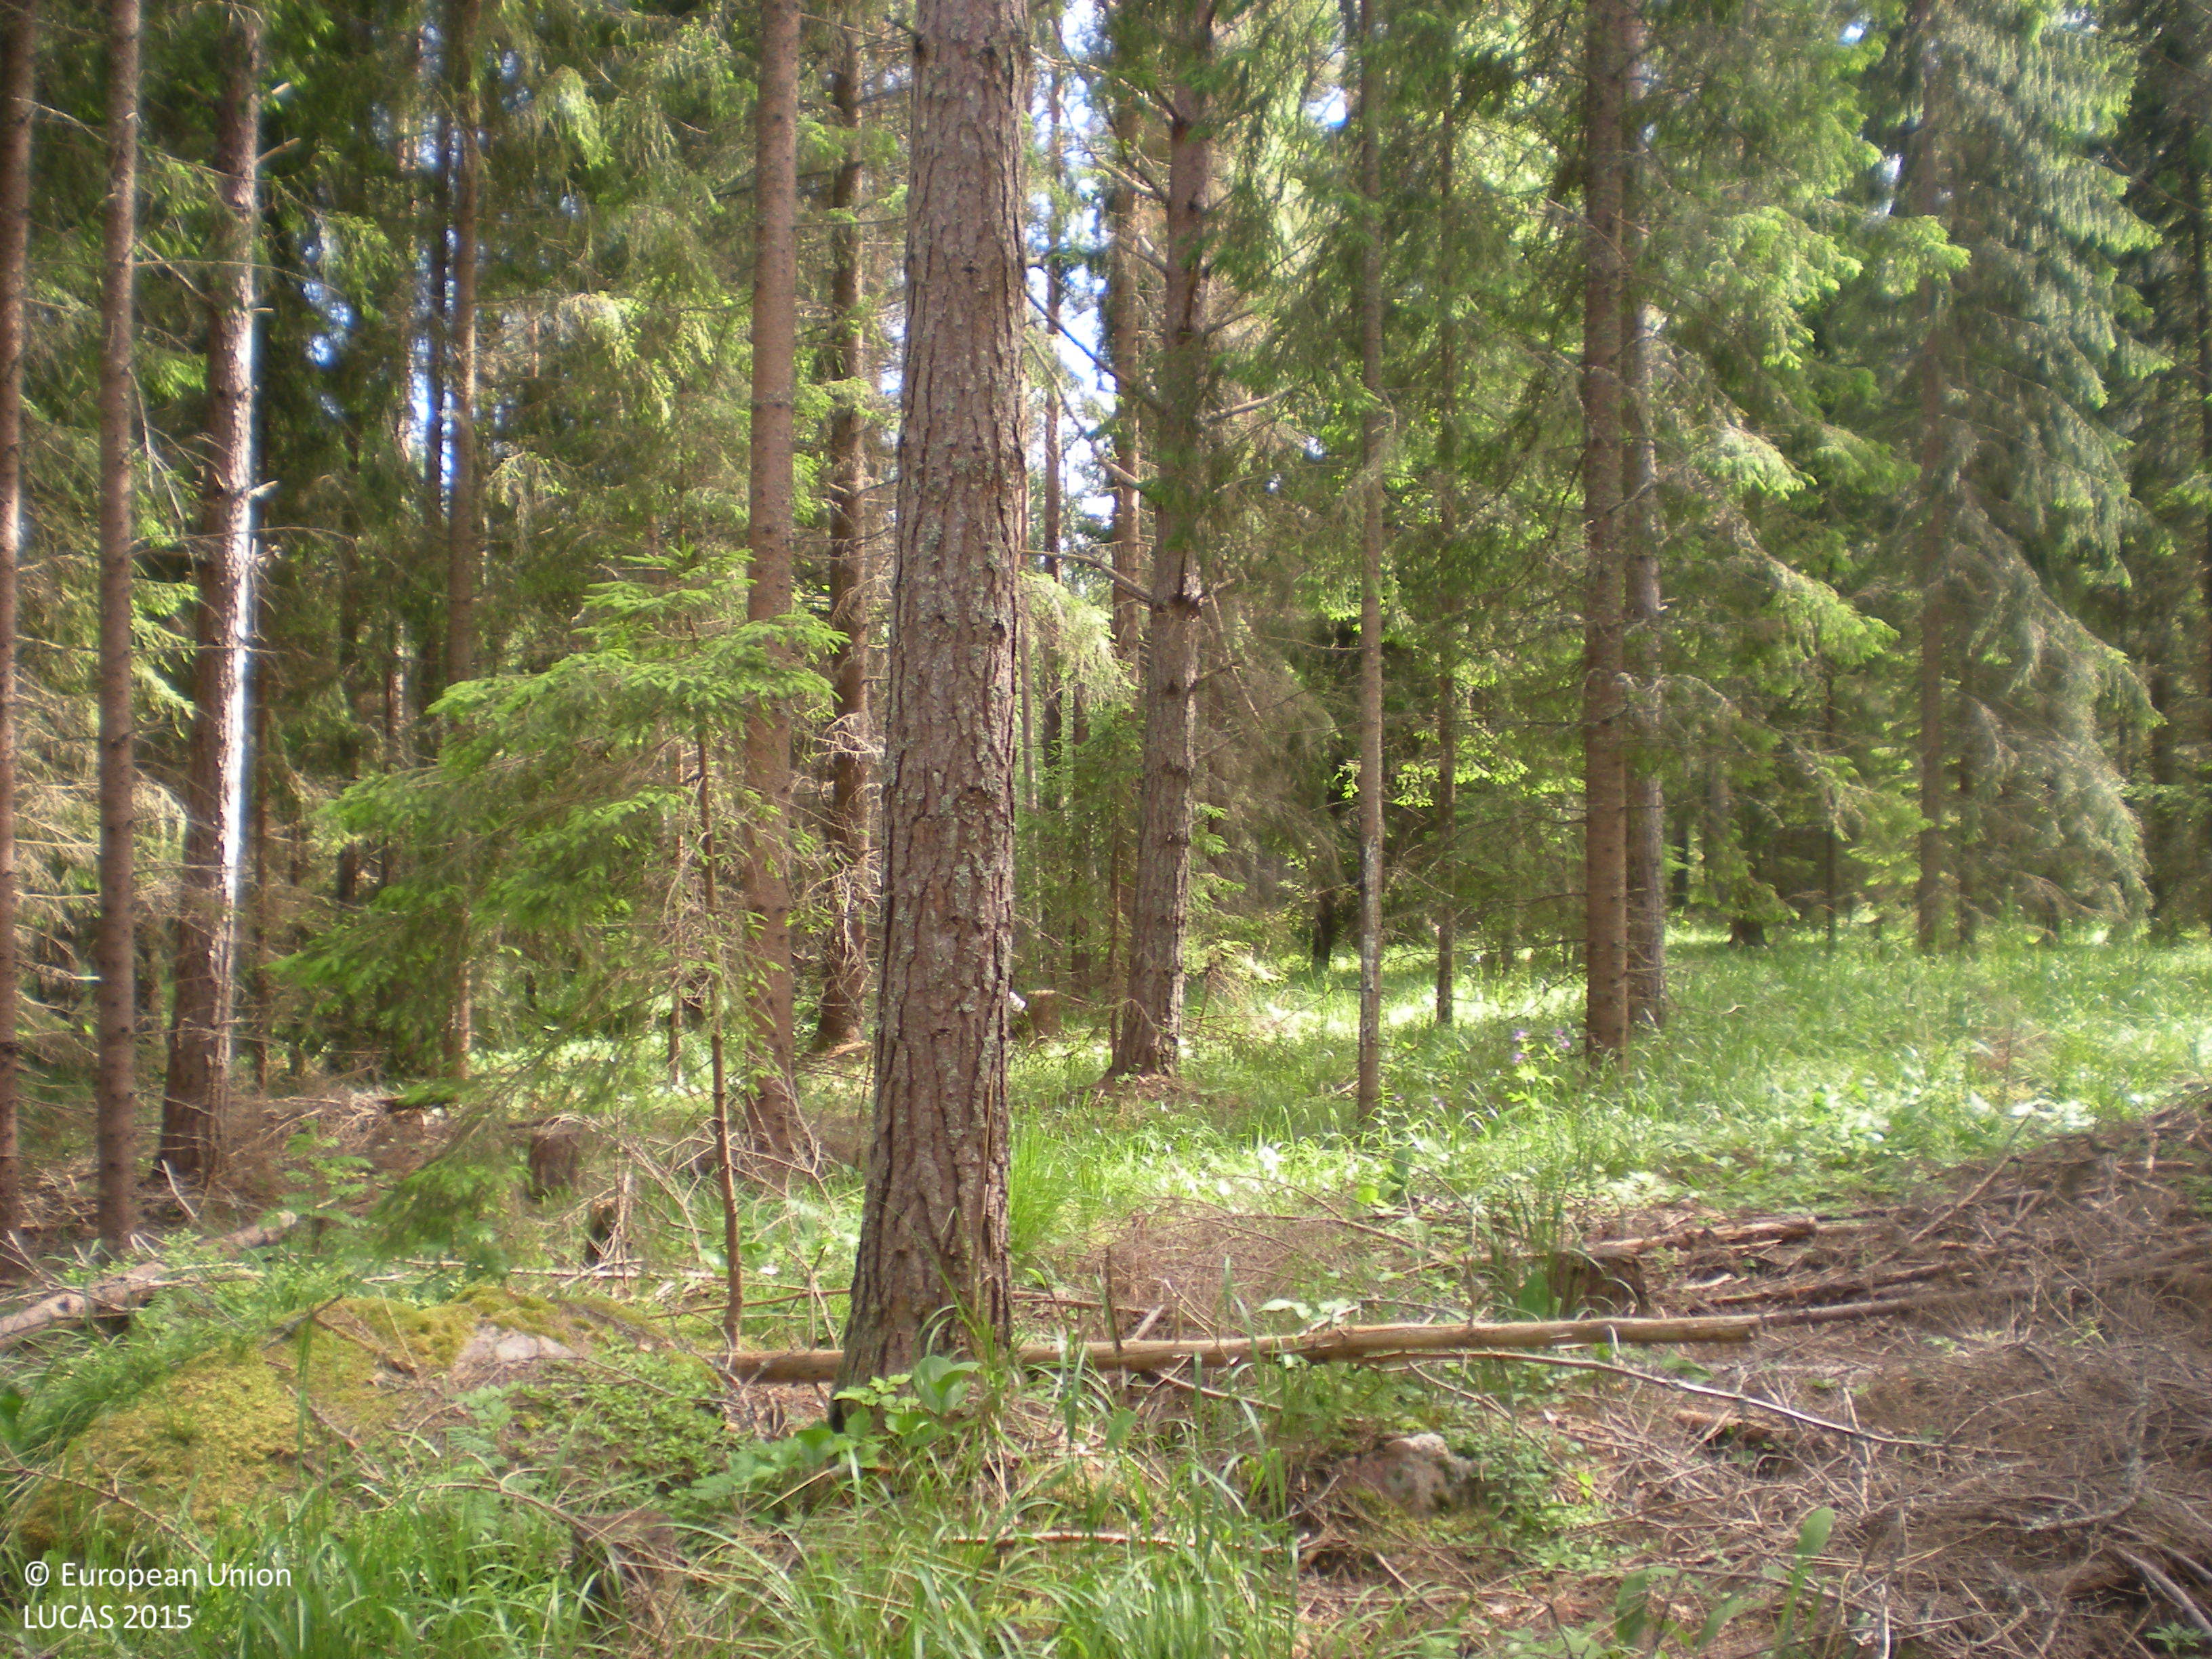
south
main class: Woodland
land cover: Other coniferous woodland
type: boreal forest
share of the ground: 50 - 75 %
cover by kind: coniferous forest trees 70 %, herbaceous plants 15 %, lichens and mosses 10 %, consolidated bare surface 5 %
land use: Forestry
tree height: > 5 m
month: June
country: SE
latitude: 60.4301
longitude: 17.8950
